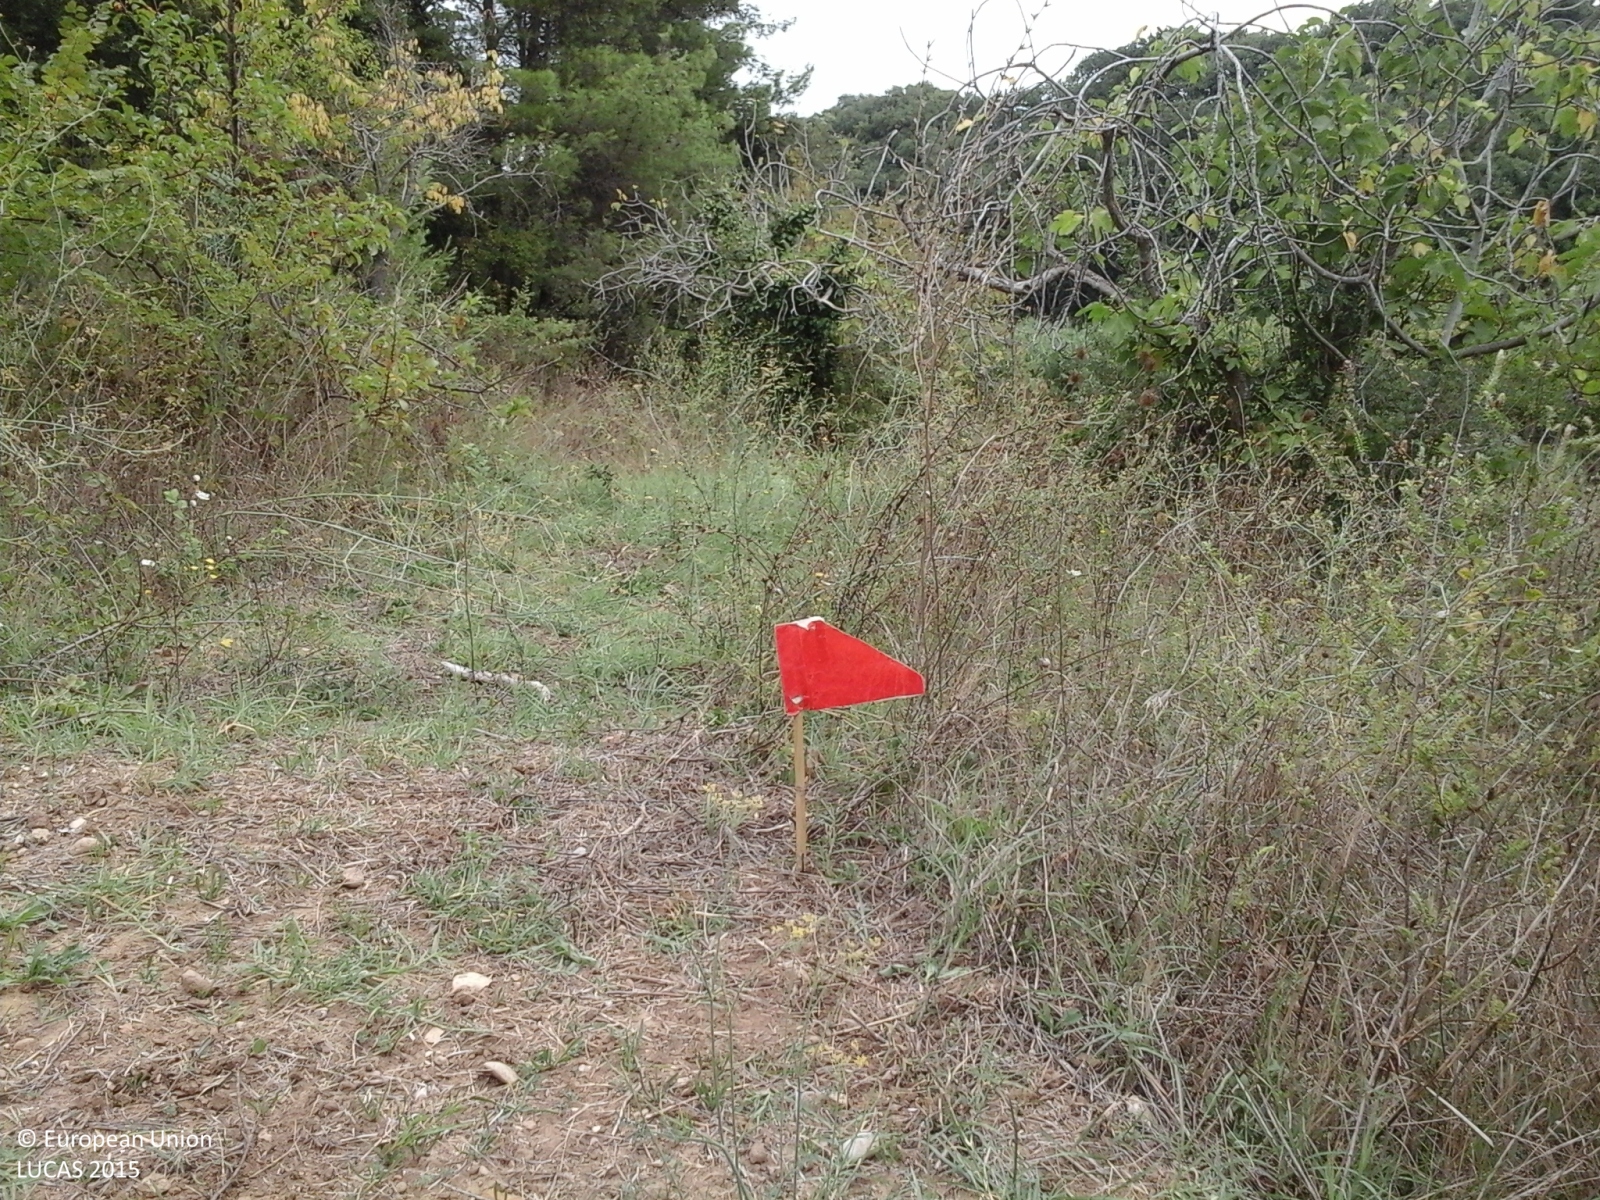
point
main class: Cropland
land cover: Apple fruit
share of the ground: > 75 %
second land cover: Spontaneously vegetated surfaces
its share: > 75 %
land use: Agriculture (excluding fallow land and kitchen gardens)
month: September
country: IT
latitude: 41.8520
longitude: 15.1754
